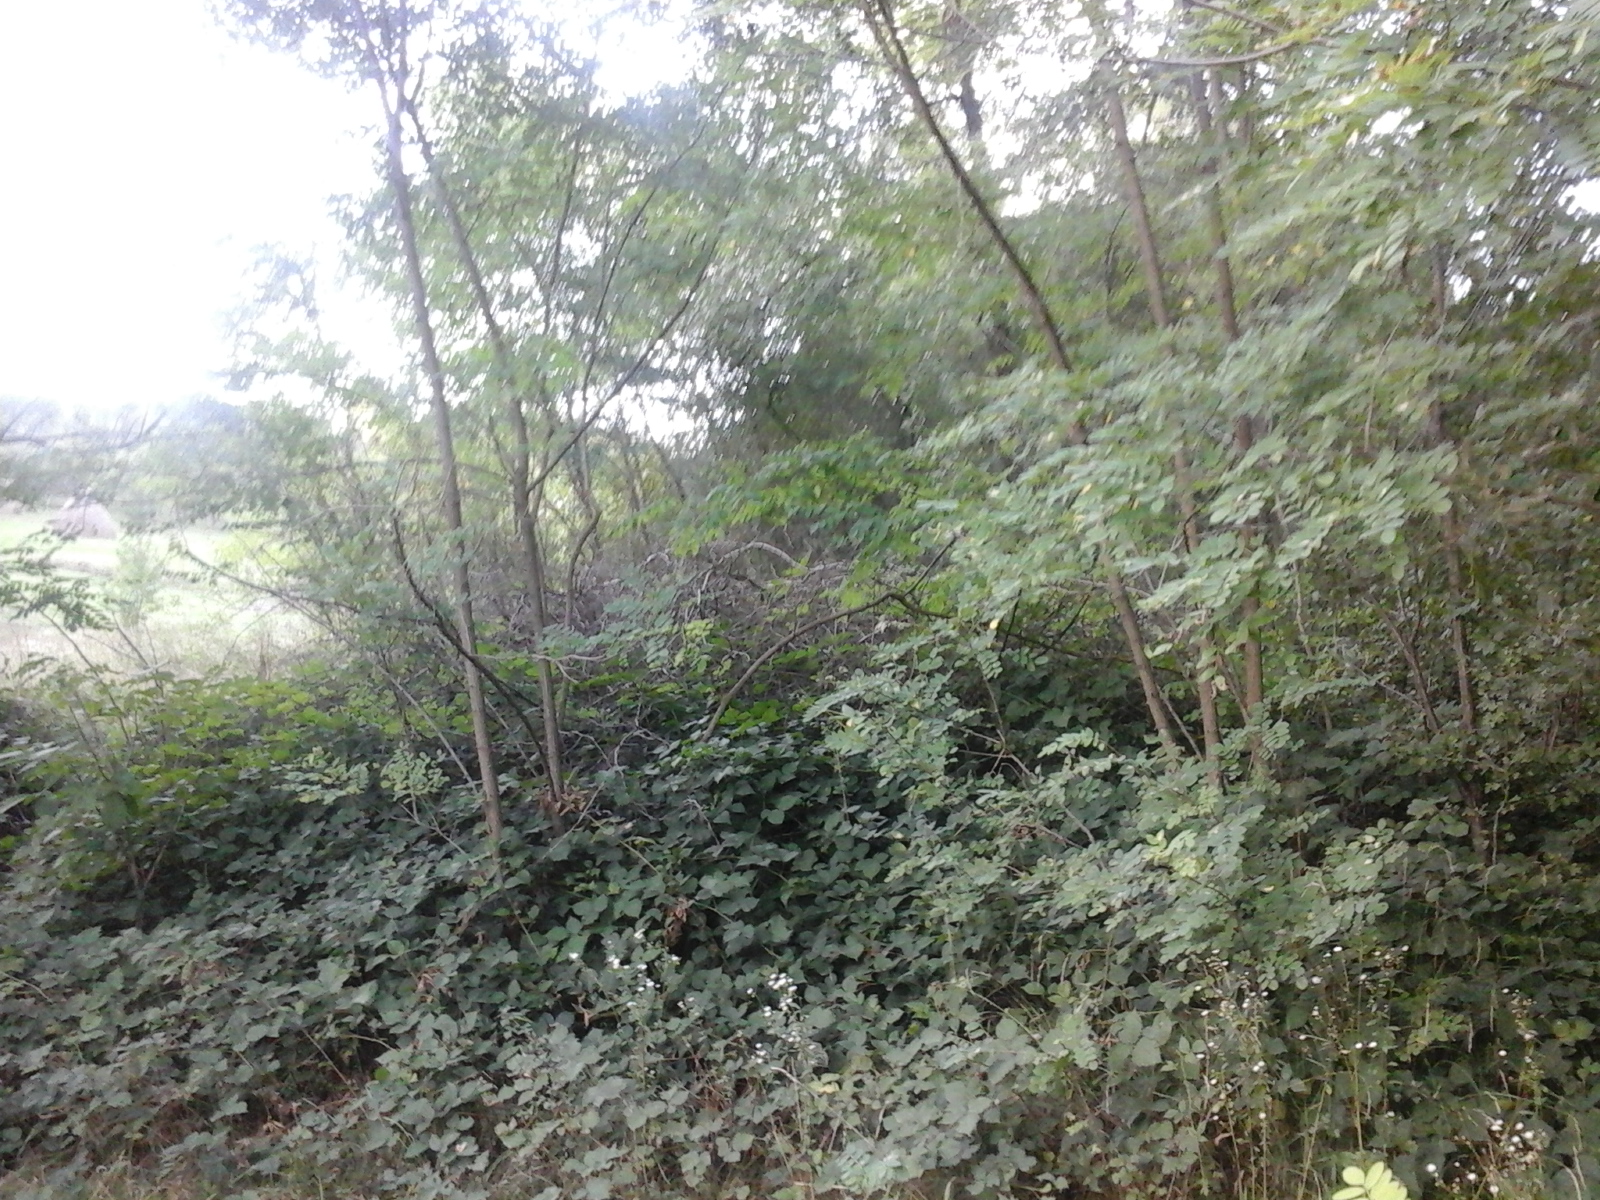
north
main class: Woodland
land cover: Broadleaved woodland
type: exotic forest
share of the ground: > 75 %
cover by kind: broadleaved forest trees 100 %
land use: Forestry
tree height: > 5 m
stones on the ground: < 10 %
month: September
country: RO
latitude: 47.9419
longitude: 23.4496
